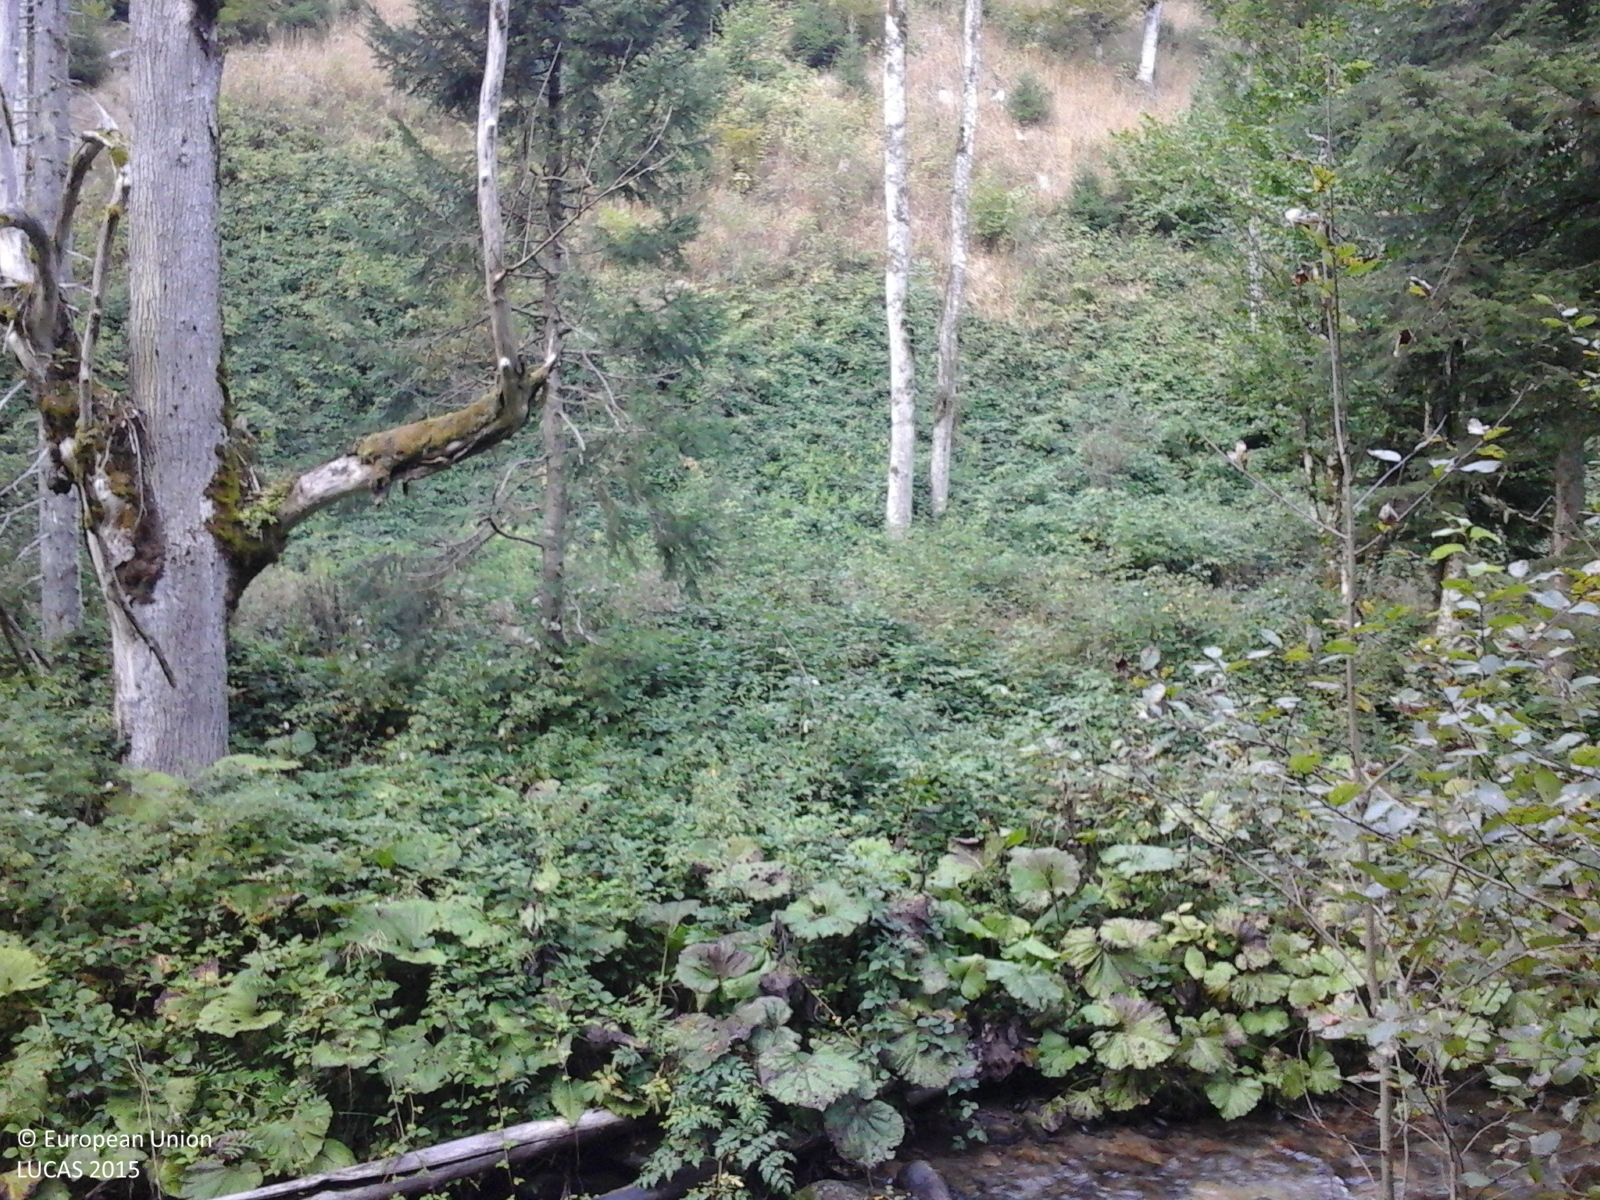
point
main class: Woodland
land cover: Spruce dominated mixed woodland
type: alpine coniferous forest
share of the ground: 50 - 75 %
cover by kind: coniferous forest trees 60 %, broadleaved forest trees 40 %
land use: Forestry
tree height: > 5 m
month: September
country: RO
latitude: 45.3870
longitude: 22.5752
